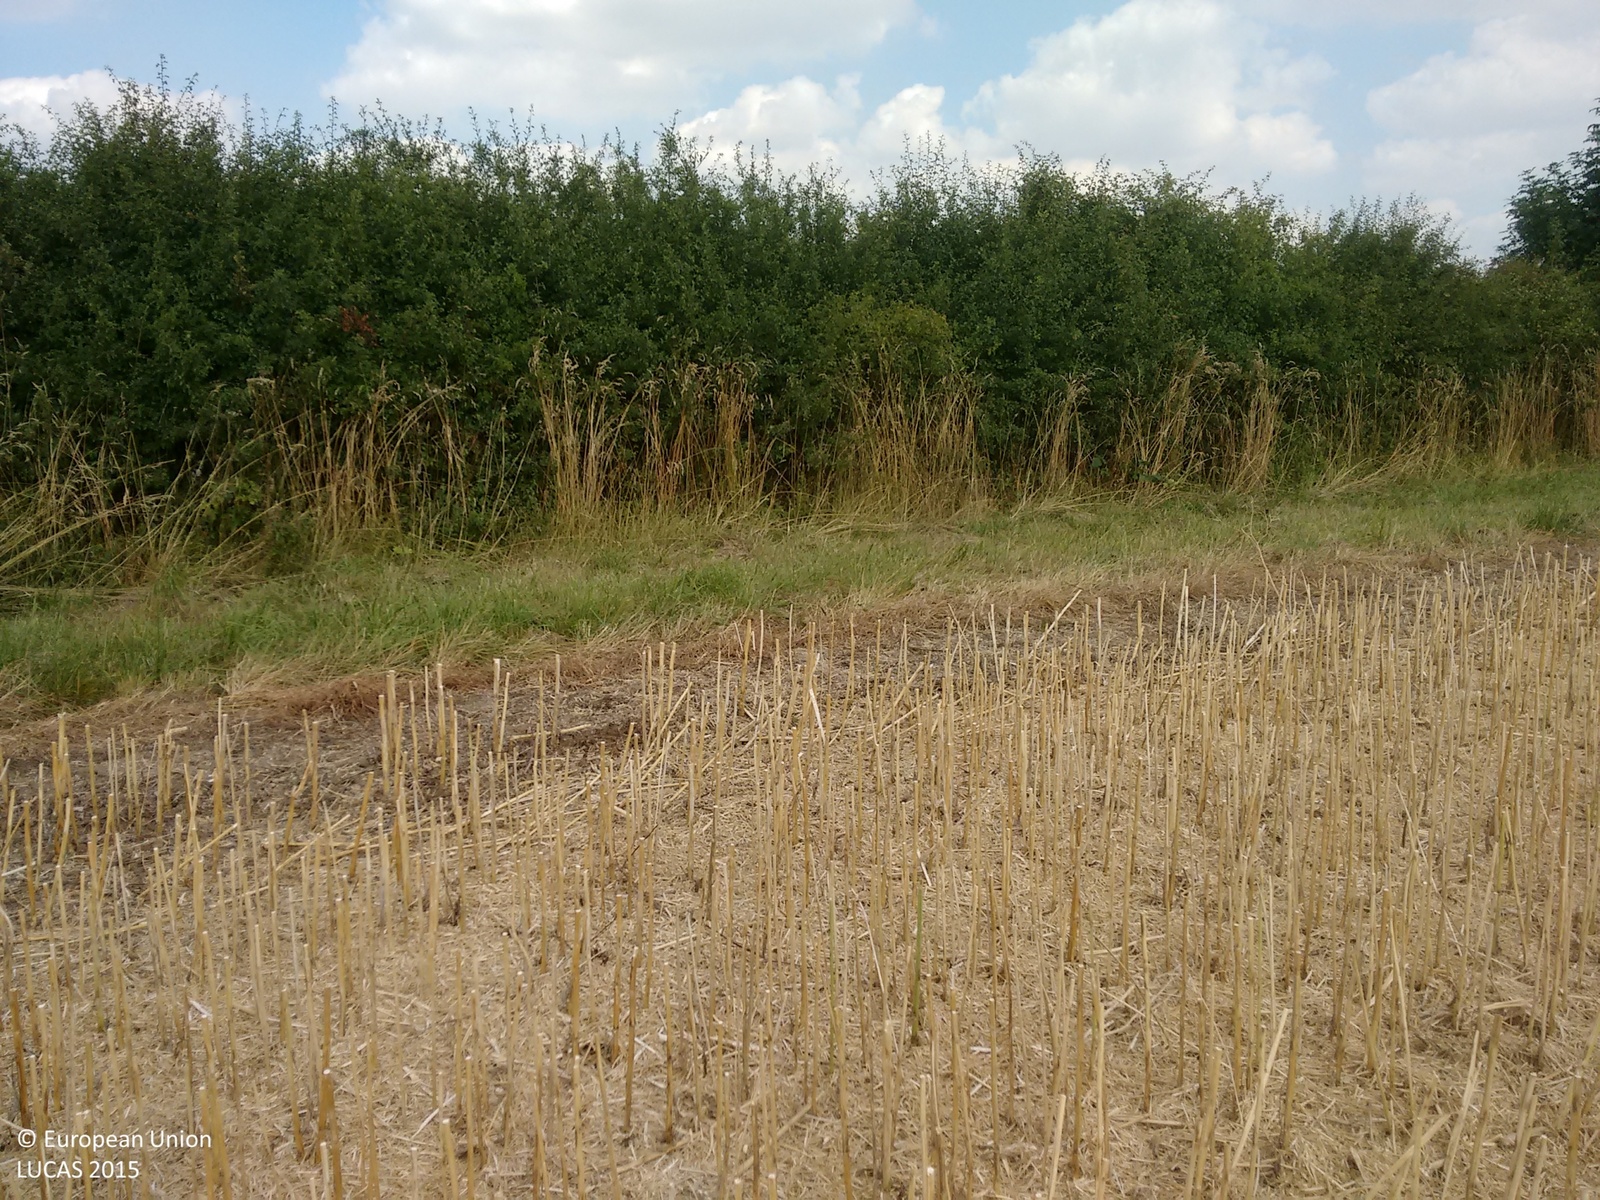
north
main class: Cropland
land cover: Rape and turnip rape
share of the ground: > 75 %
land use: Agriculture (excluding fallow land and kitchen gardens)
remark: Harvested field
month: August
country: GB
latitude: 52.6011
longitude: -1.4635
